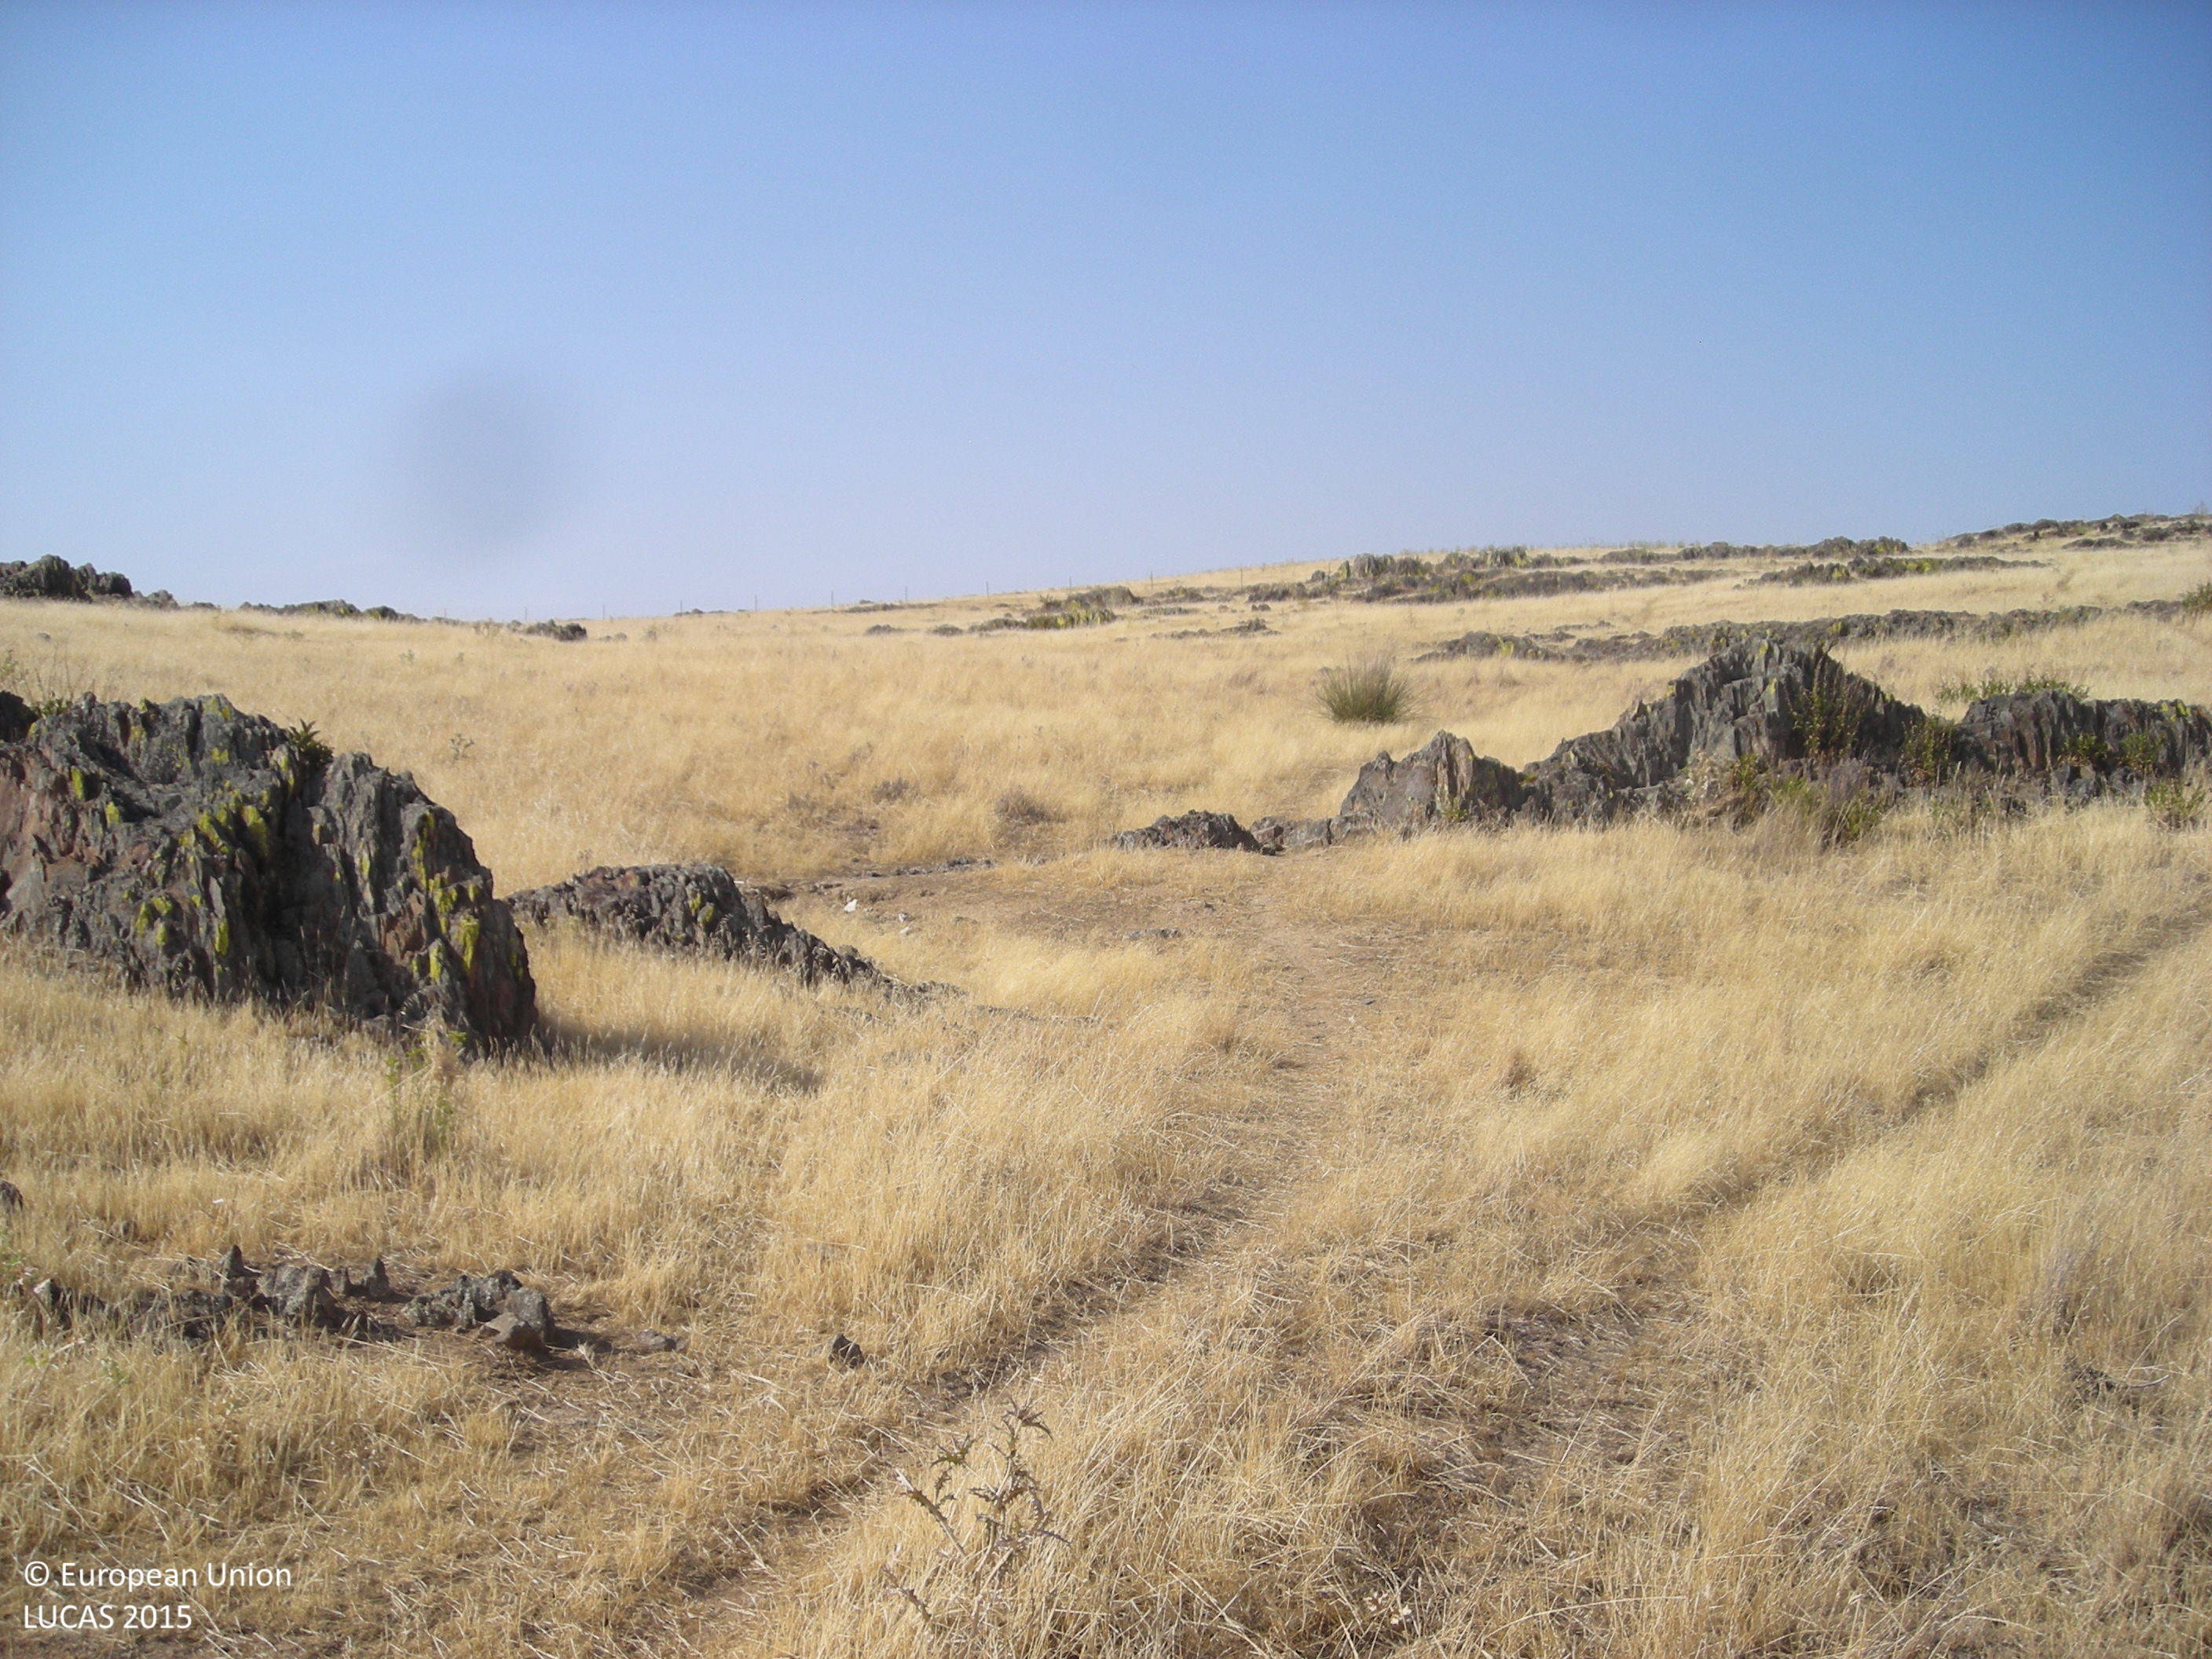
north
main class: Grassland
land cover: Grassland without tree/shrub cover
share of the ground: > 75 %
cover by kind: herbaceous plants 100 %
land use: Agriculture (excluding fallow land and kitchen gardens)
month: July
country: ES
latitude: 38.8055
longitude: -5.5056
